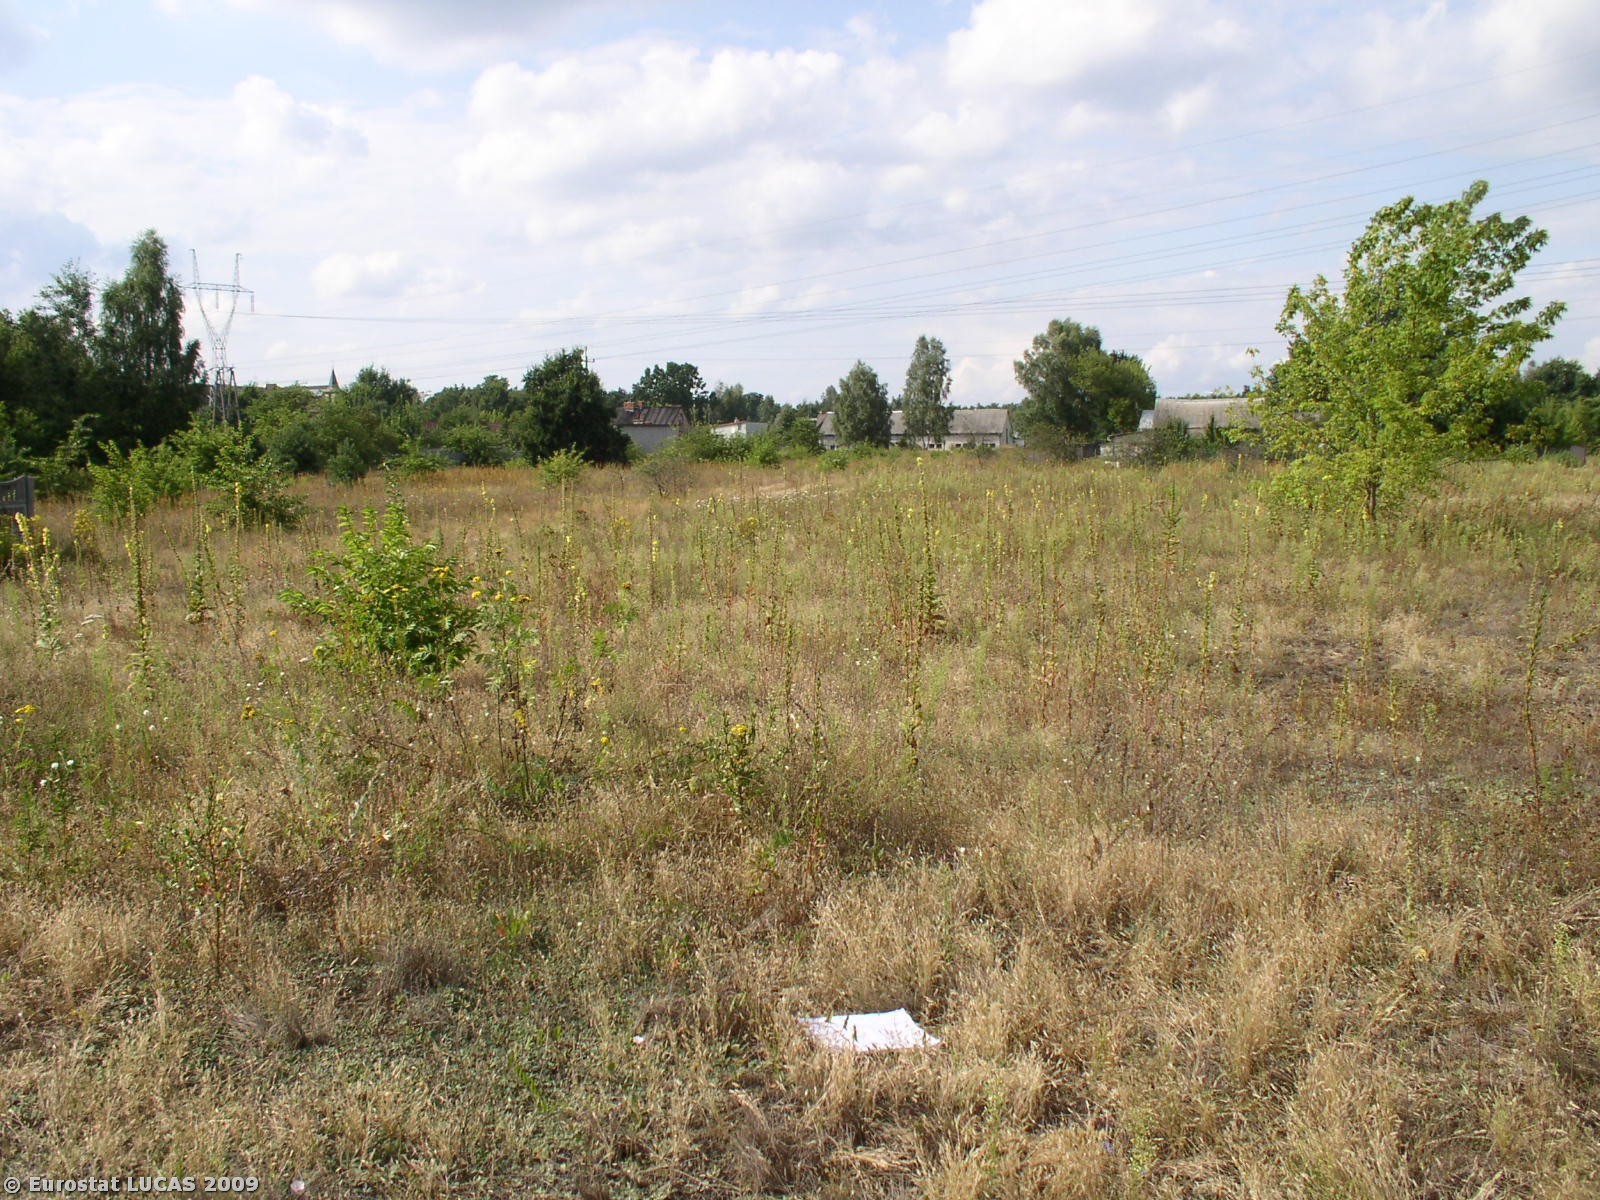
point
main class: Grassland
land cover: Spontaneously vegetated surfaces
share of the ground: > 75 %
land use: Unused
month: August
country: PL
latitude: 52.2402
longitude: 21.2506
